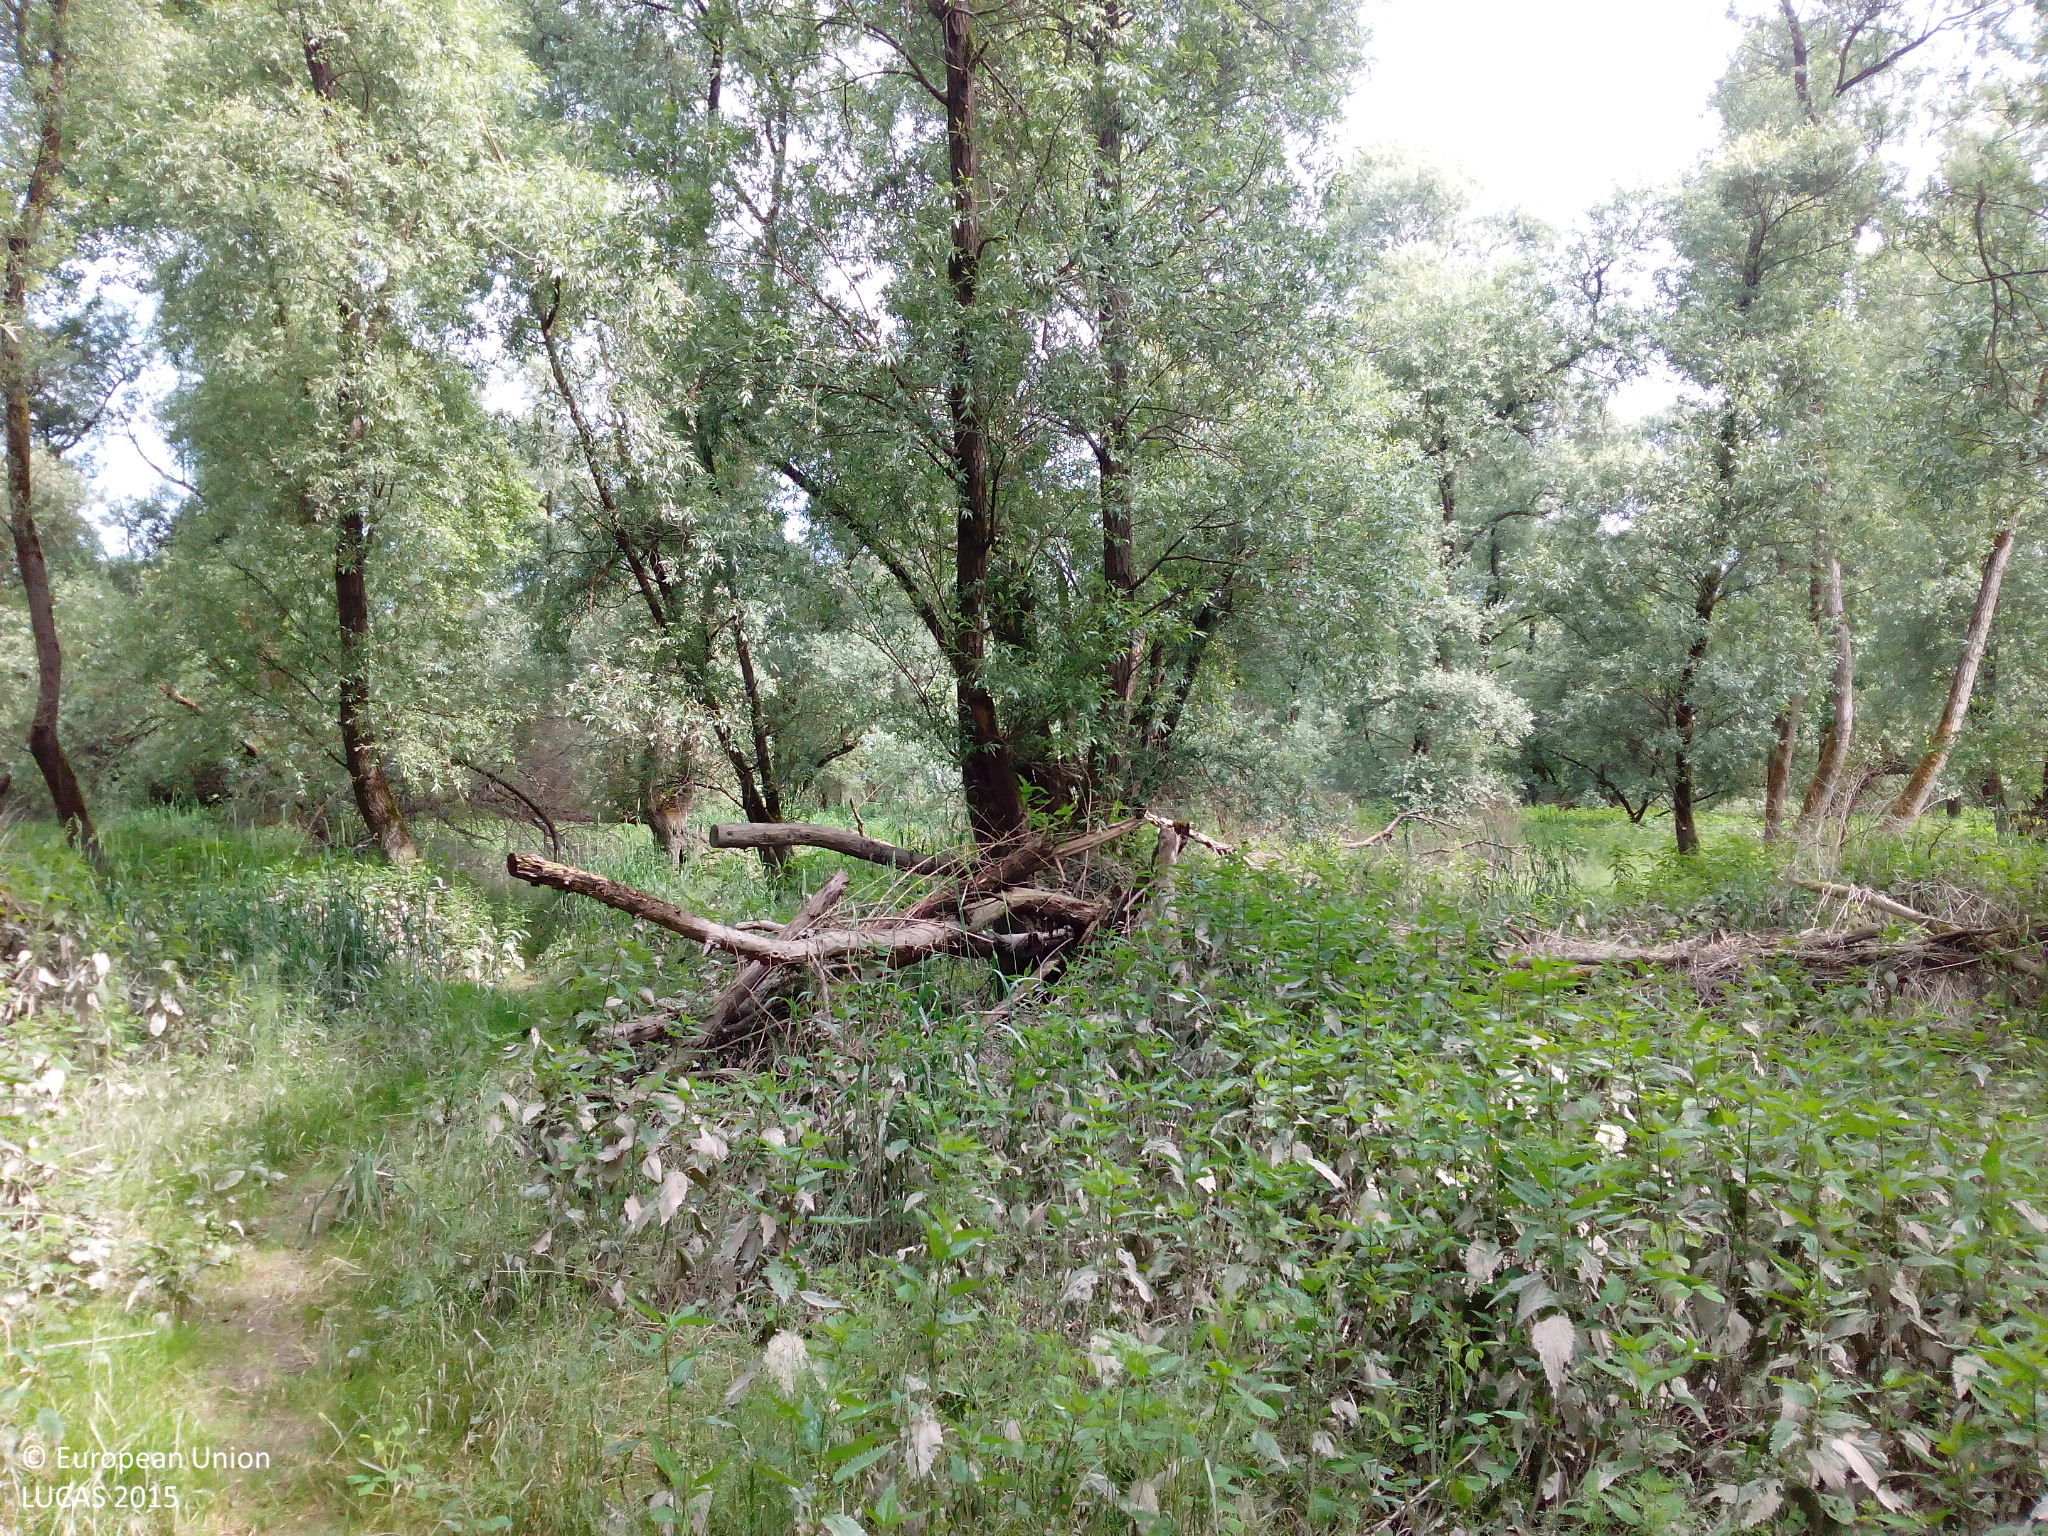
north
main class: Woodland
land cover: Broadleaved woodland
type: floodplain forest
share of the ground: 25 - 50 %
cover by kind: broadleaved forest trees 60 %, herbaceous plants 20 %, unconsolidated bare surface 20 %
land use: Semi-natural and natural areas not in use
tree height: > 5 m
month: May
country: DE
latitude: 48.9100
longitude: 8.1587
